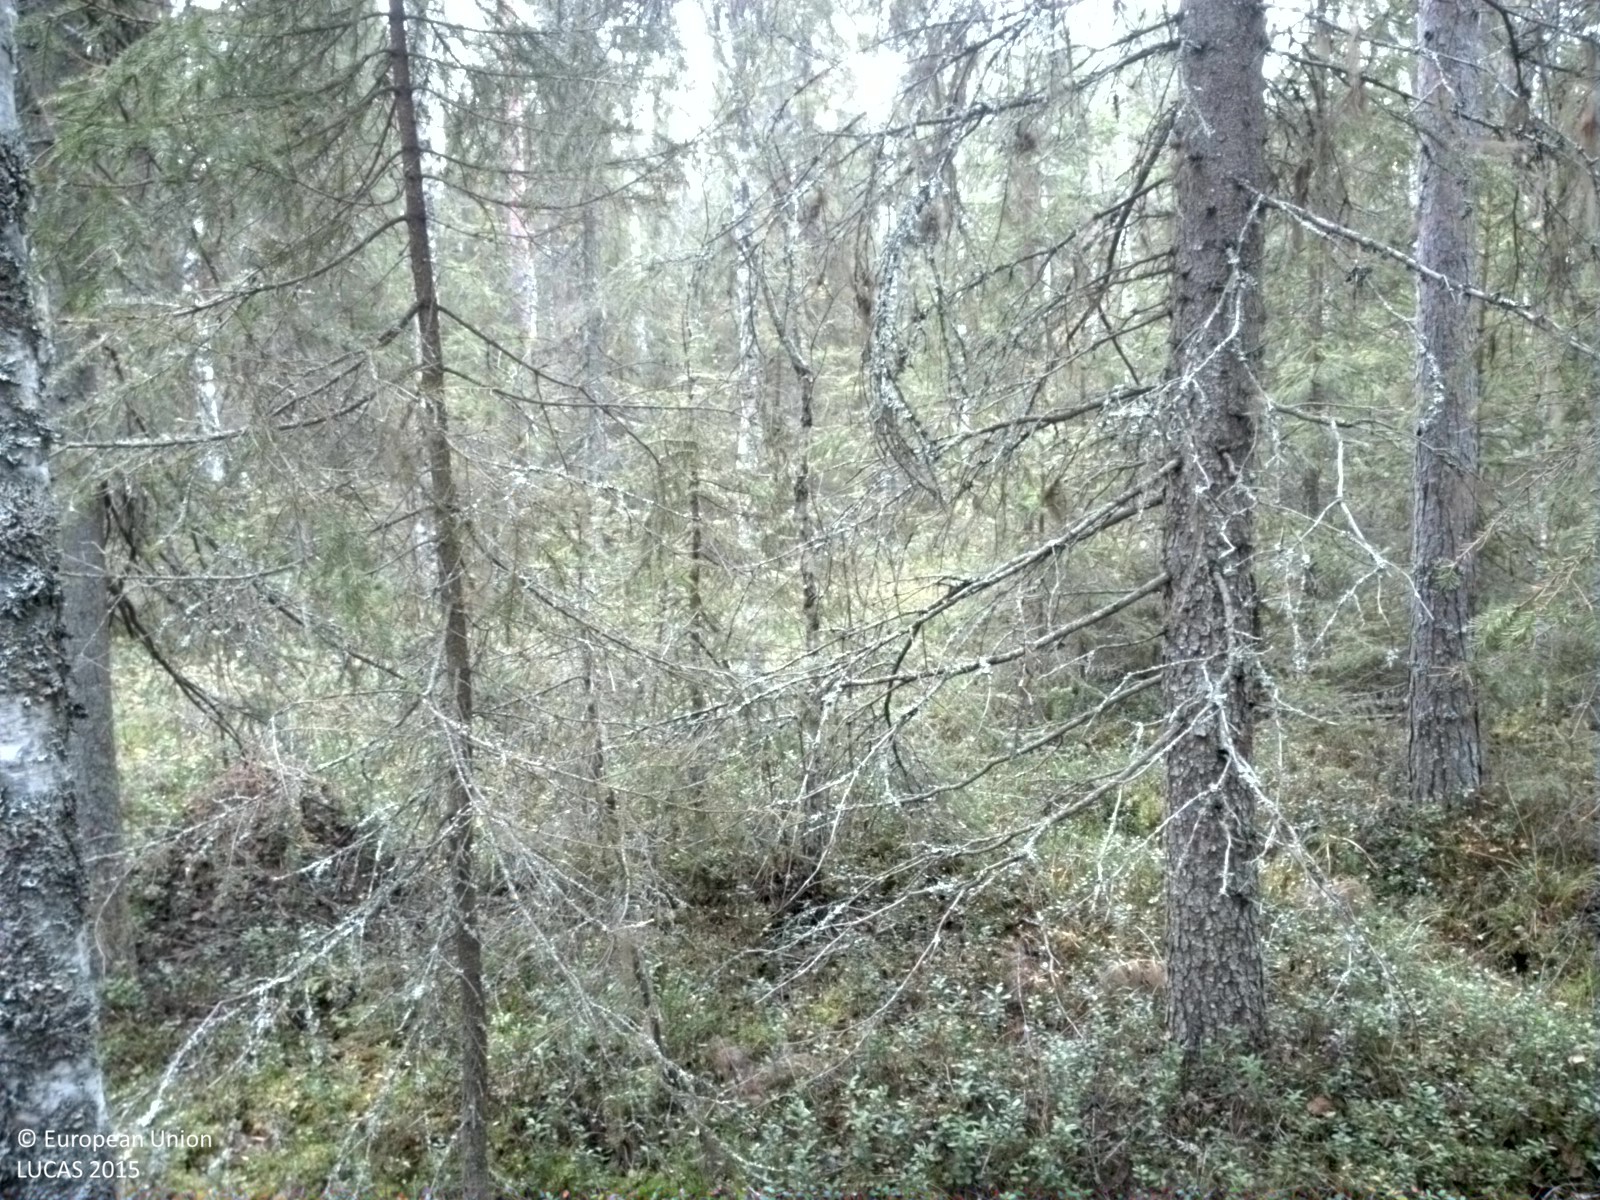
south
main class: Woodland
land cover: Spruce dominated mixed woodland
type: boreal forest
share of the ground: 50 - 75 %
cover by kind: coniferous forest trees 40 %, shrubs 40 %, broadleaved forest trees 15 %, lichens and mosses 5 %
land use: Forestry
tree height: > 5 m
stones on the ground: < 10 %
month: October
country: SE
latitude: 65.6577
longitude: 21.0358
